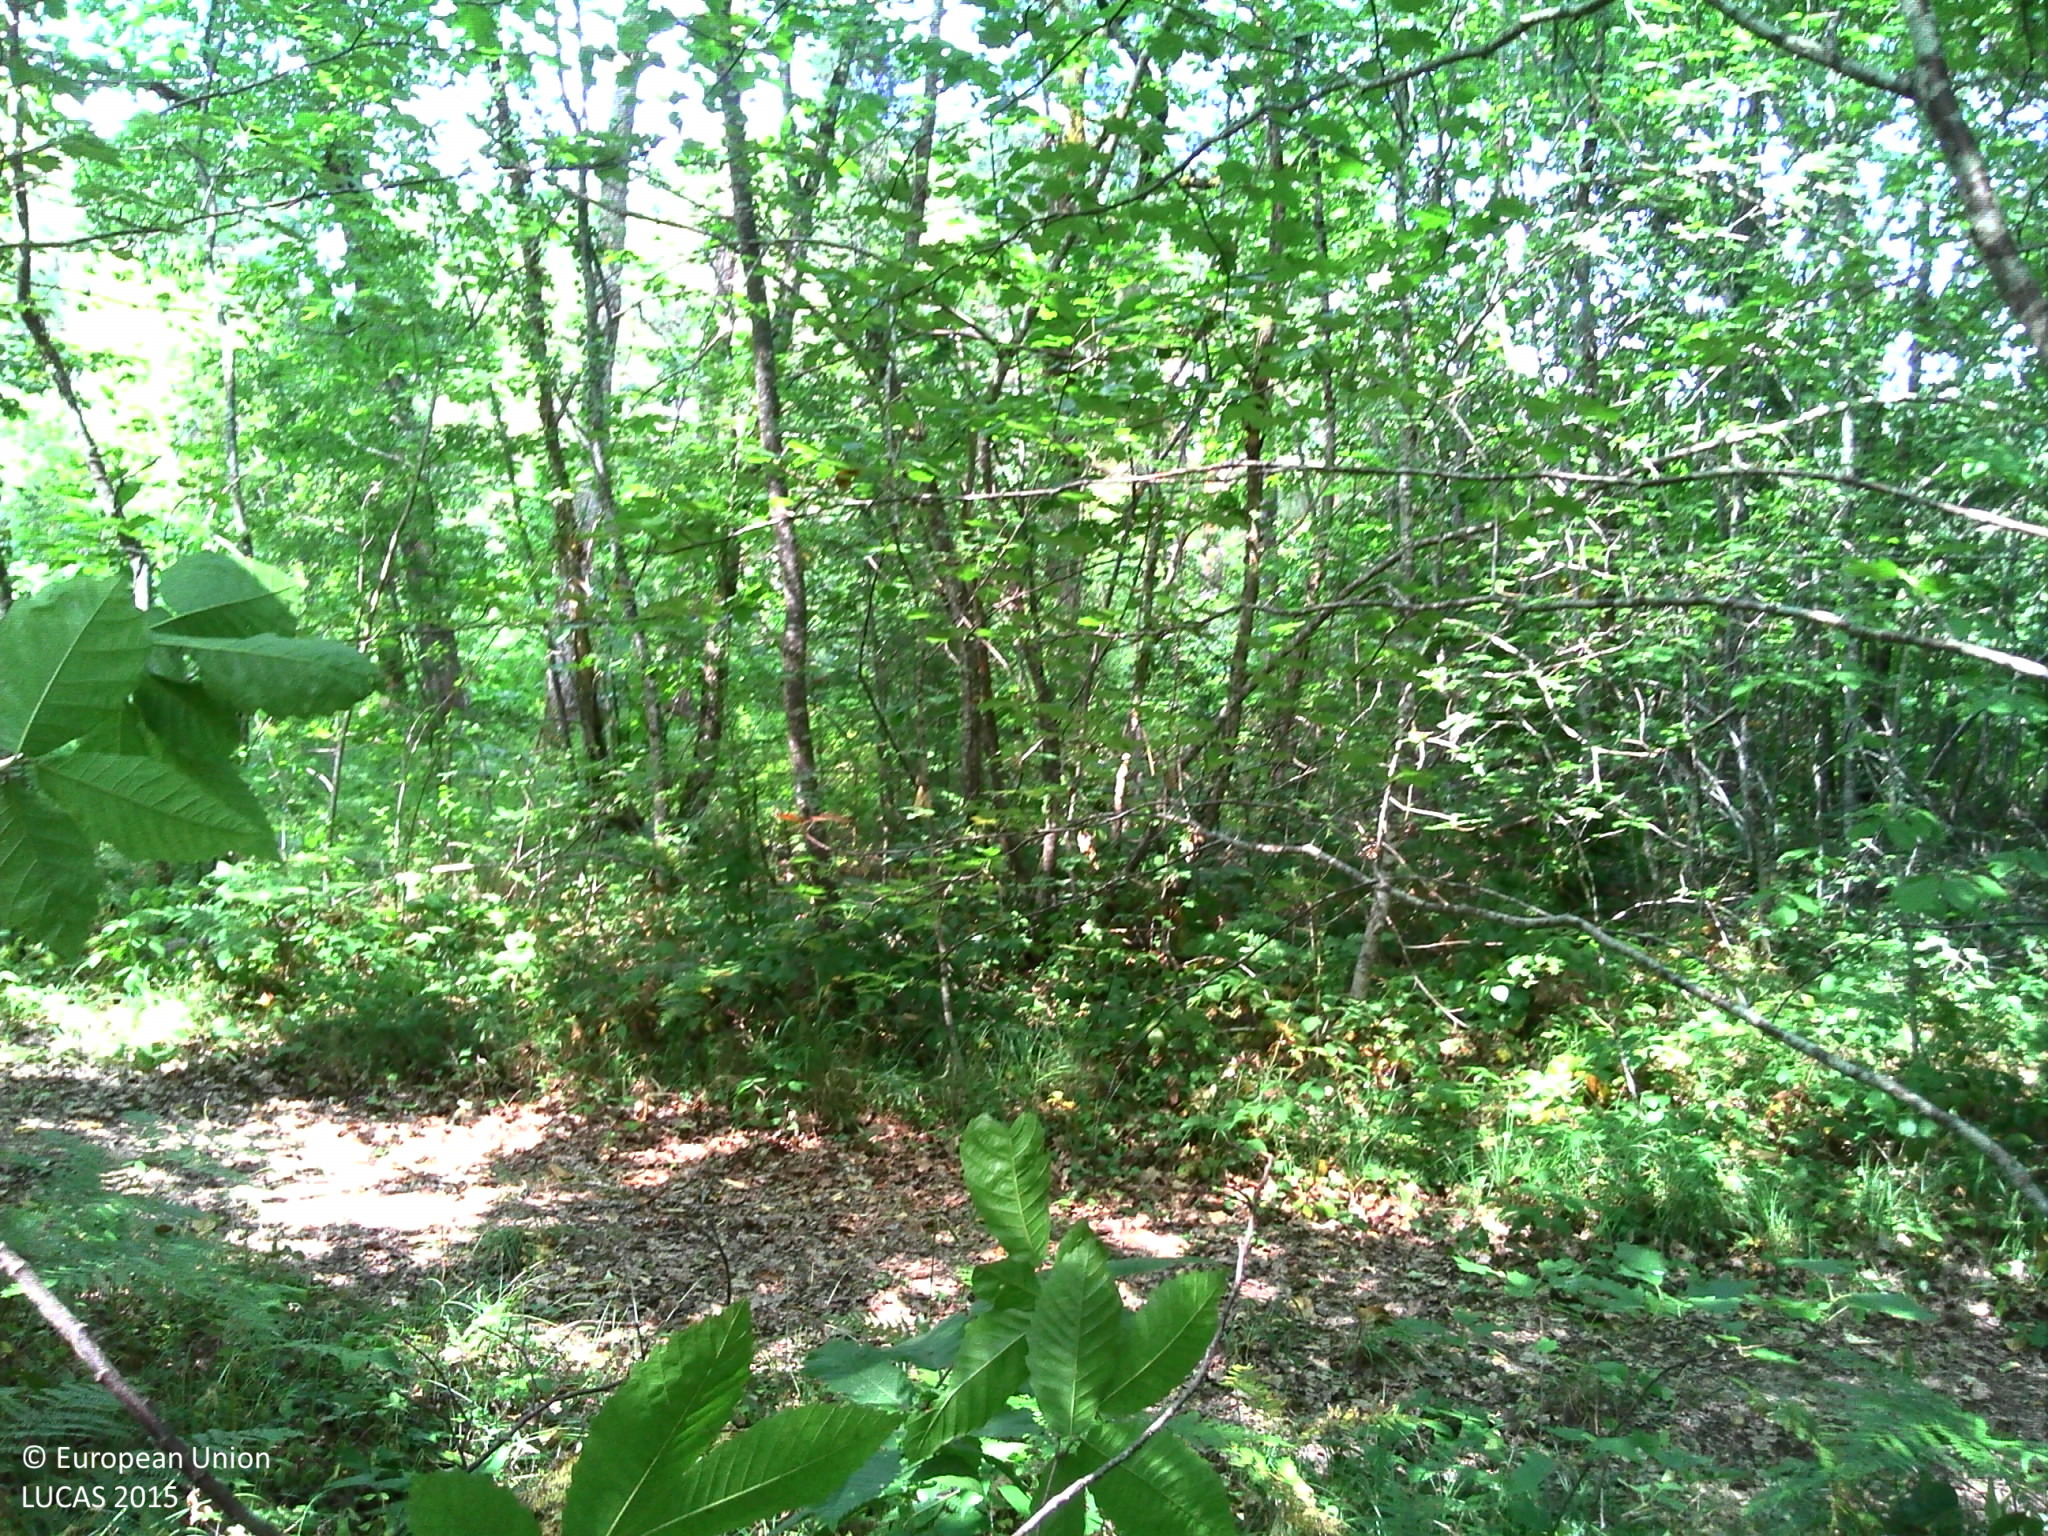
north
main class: Woodland
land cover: Broadleaved woodland
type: thermophilous deciduous forest
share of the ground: > 75 %
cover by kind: broadleaved forest trees 75 %, herbaceous plants 15 %, shrubs 10 %
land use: Forestry
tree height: > 5 m
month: July
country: FR
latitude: 45.1737
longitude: 0.7910
